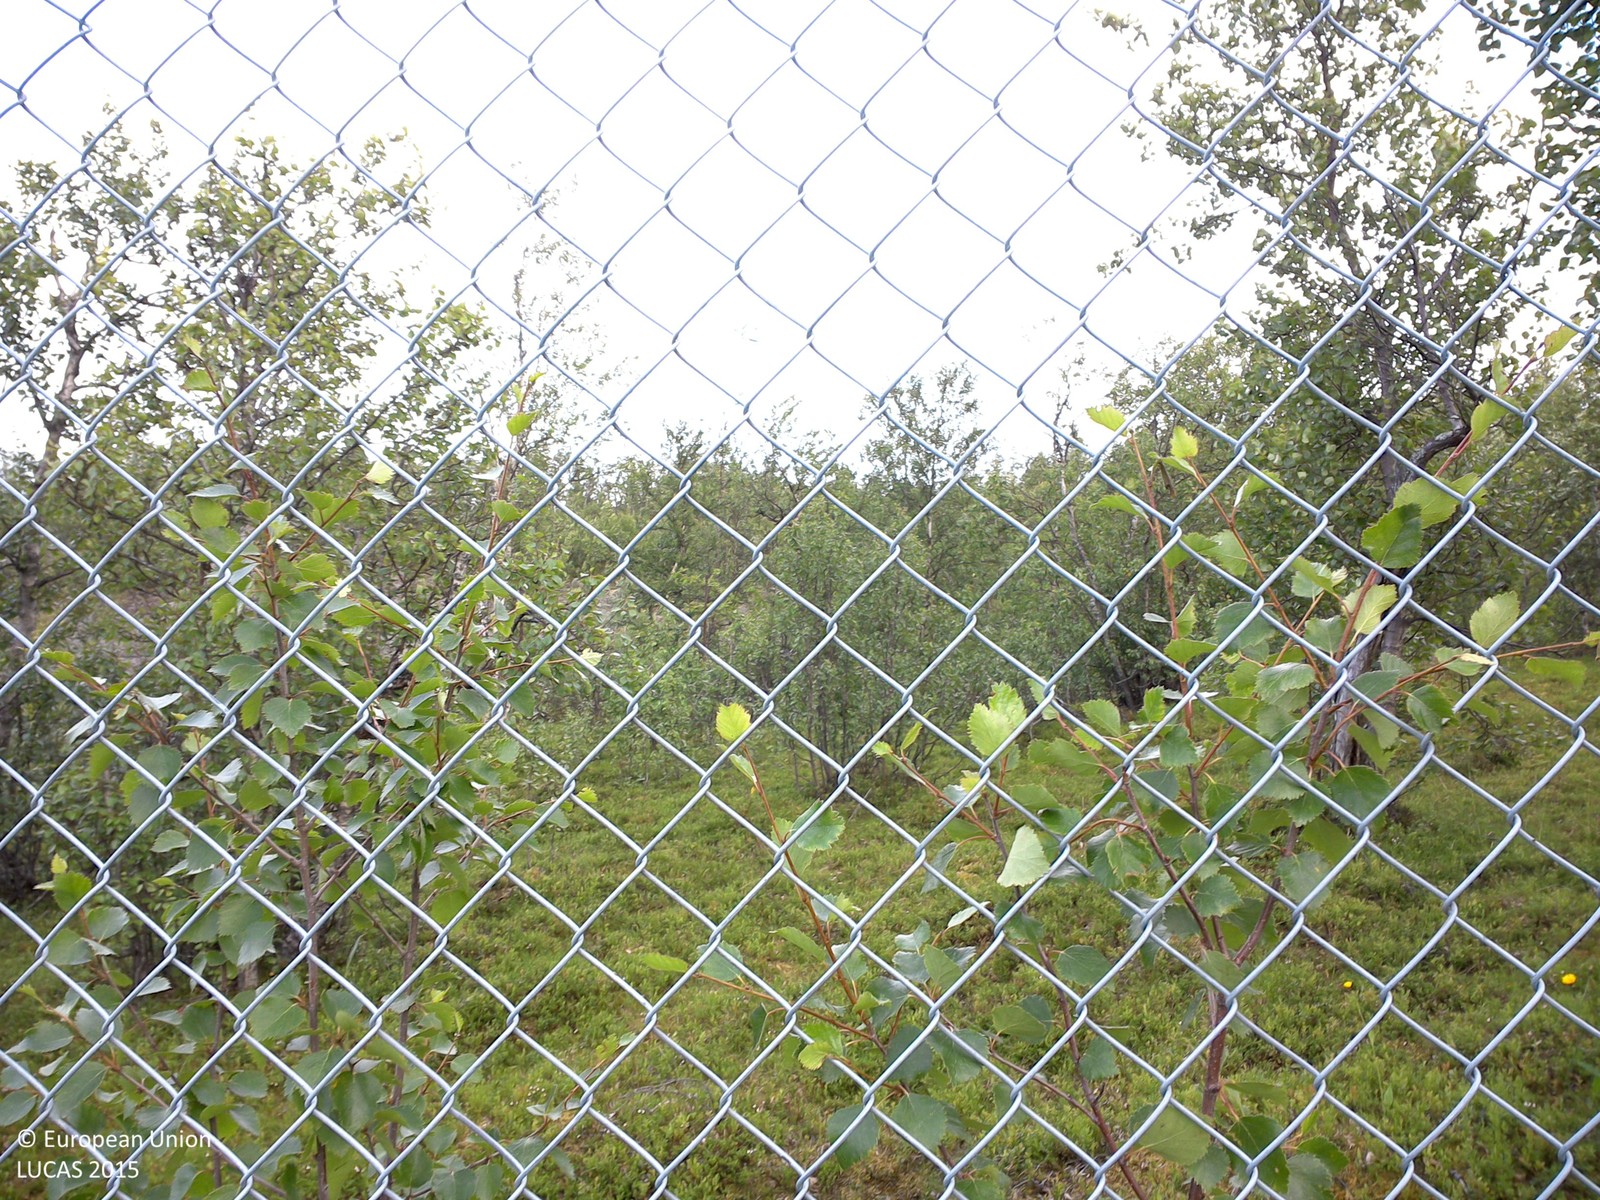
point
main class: Woodland
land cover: Broadleaved woodland
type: boreal forest
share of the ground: 10 - 25 %
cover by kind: shrubs 80 %, broadleaved forest trees 20 %
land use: Mining and quarrying
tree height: > 5 m
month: August
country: SE
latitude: 67.8728
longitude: 20.1446
